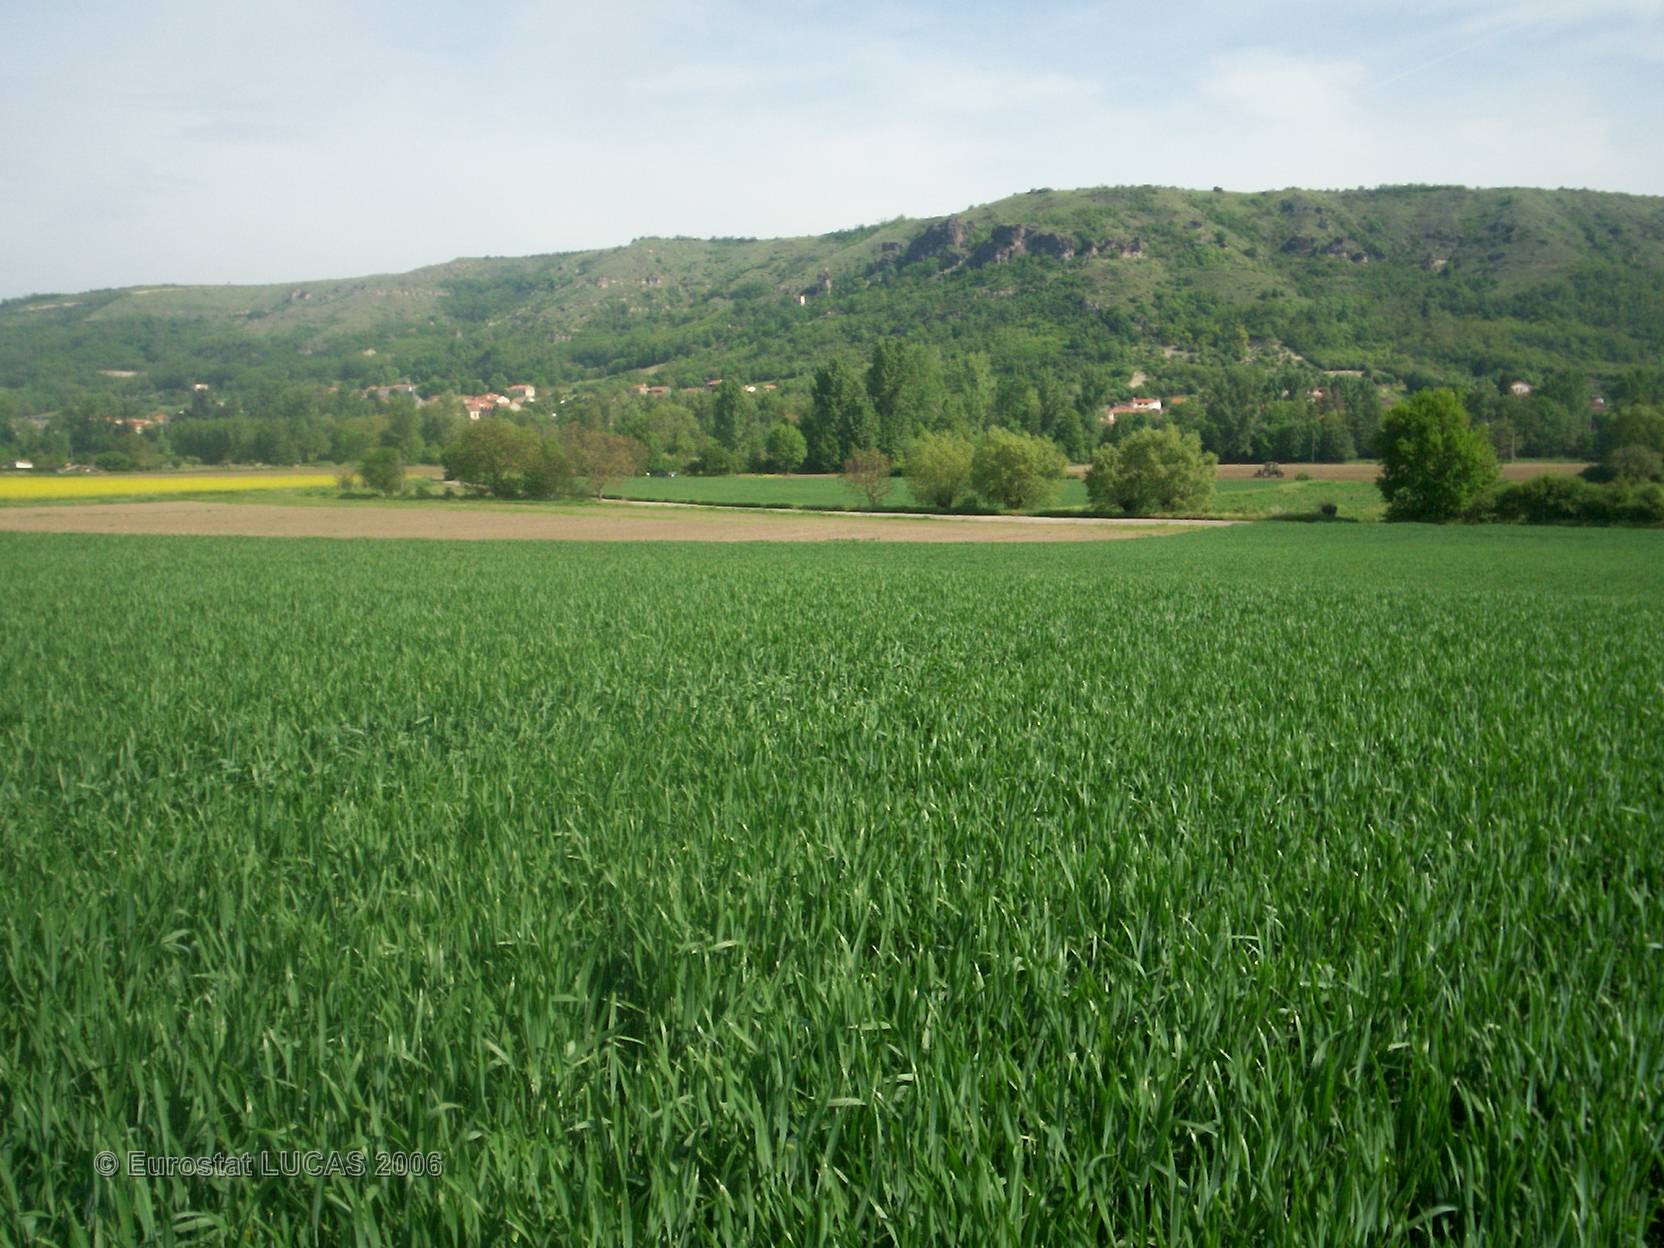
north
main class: Cropland
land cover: Common wheat
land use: Agriculture (excluding fallow land and kitchen gardens)
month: May
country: FR
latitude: 45.5382
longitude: 3.2007
